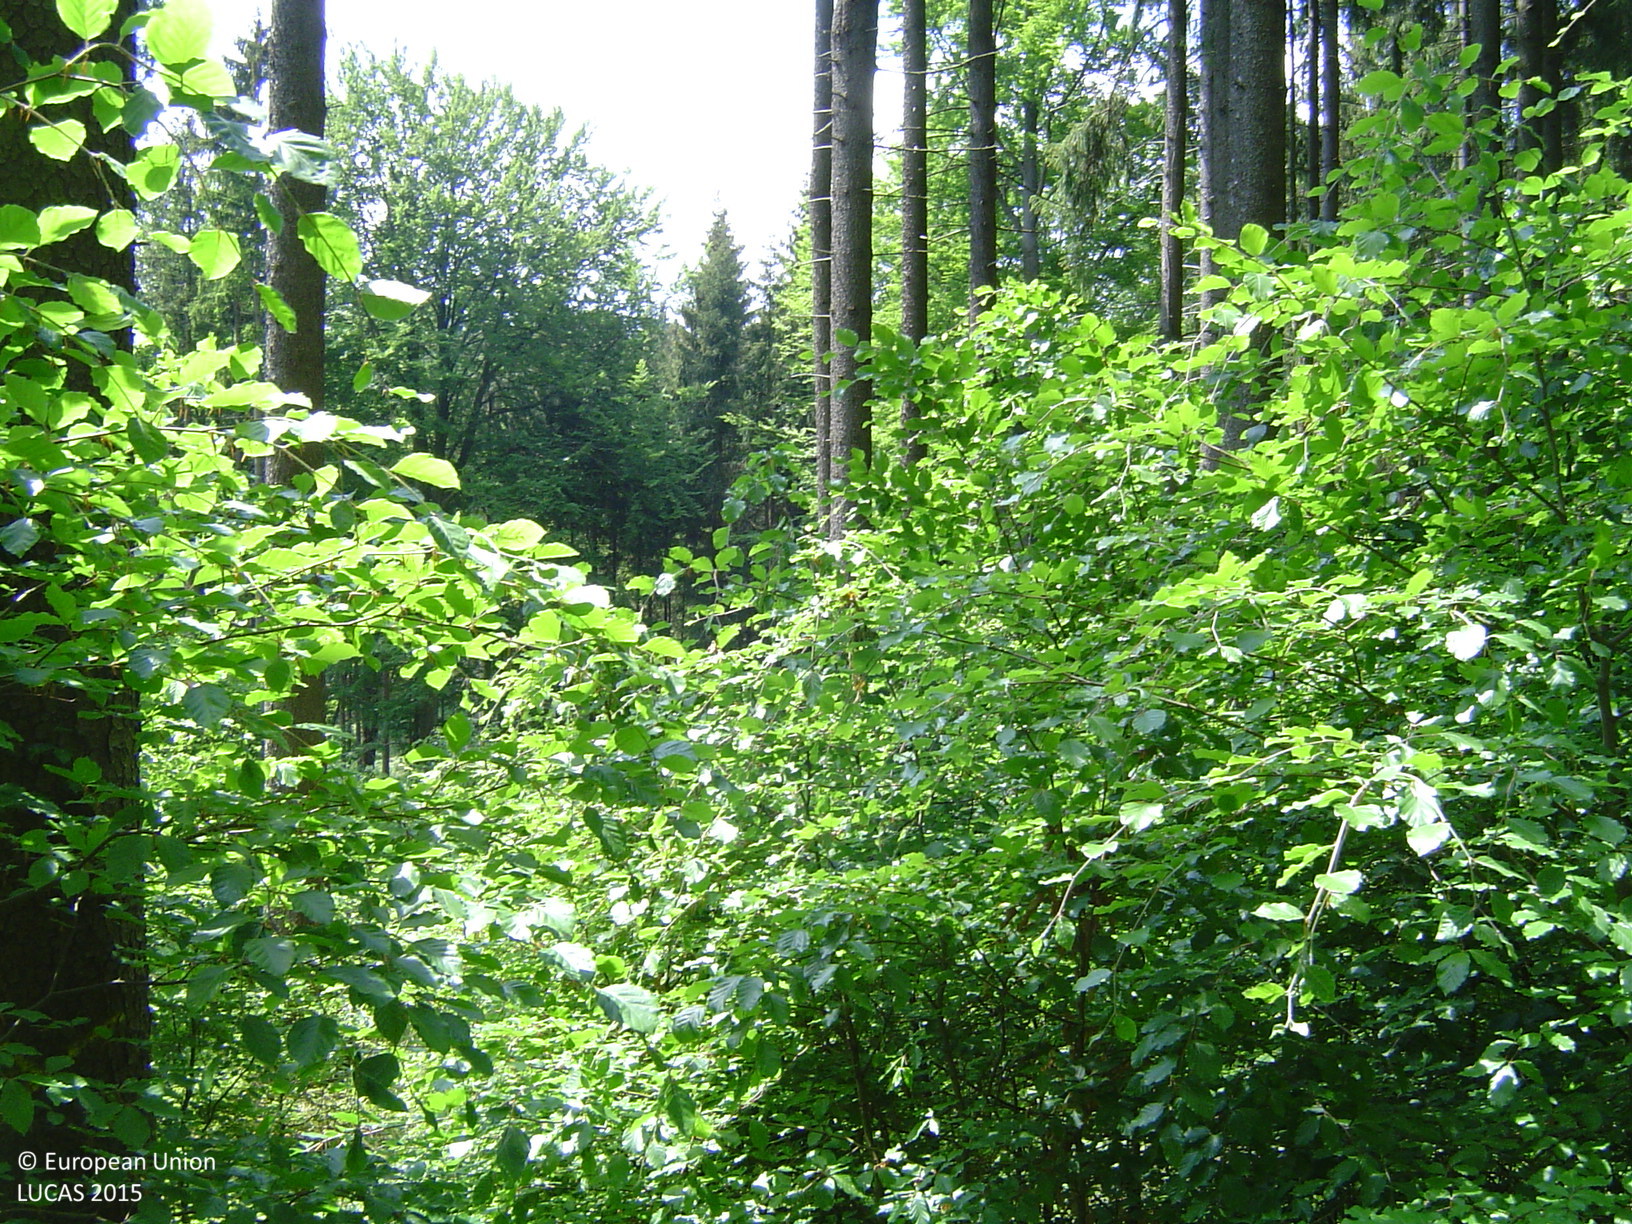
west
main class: Woodland
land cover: Spruce dominated mixed woodland
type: hemiboreal forest and nemoral coniferous forest and mixed broadleaved-coniferous forest
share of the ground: > 75 %
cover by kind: coniferous forest trees 60 %, broadleaved forest trees 40 %
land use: Forestry
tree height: > 5 m
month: May
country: CZ
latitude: 49.6324
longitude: 16.2784
